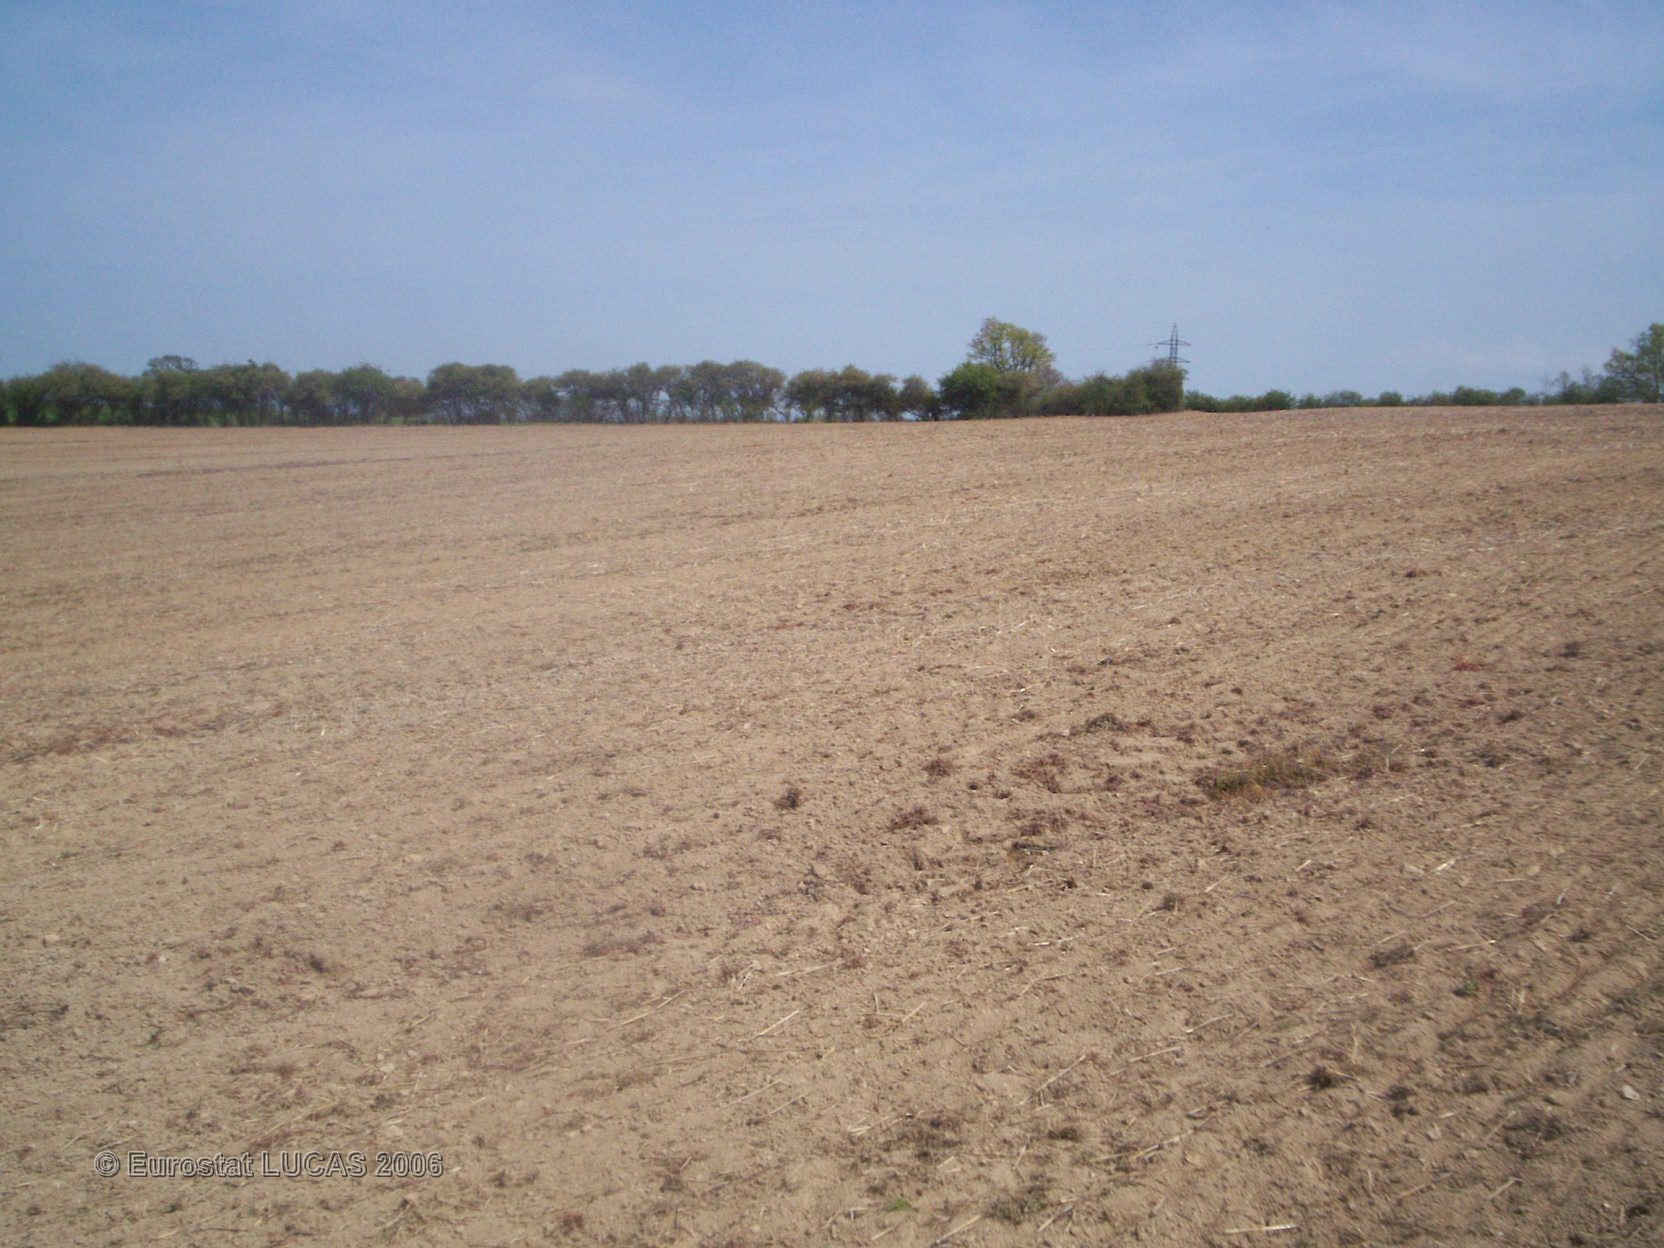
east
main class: Cropland
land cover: Barley
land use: Agriculture (excluding fallow land and kitchen gardens)
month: May
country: FR
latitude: 46.4576
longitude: 3.1623
